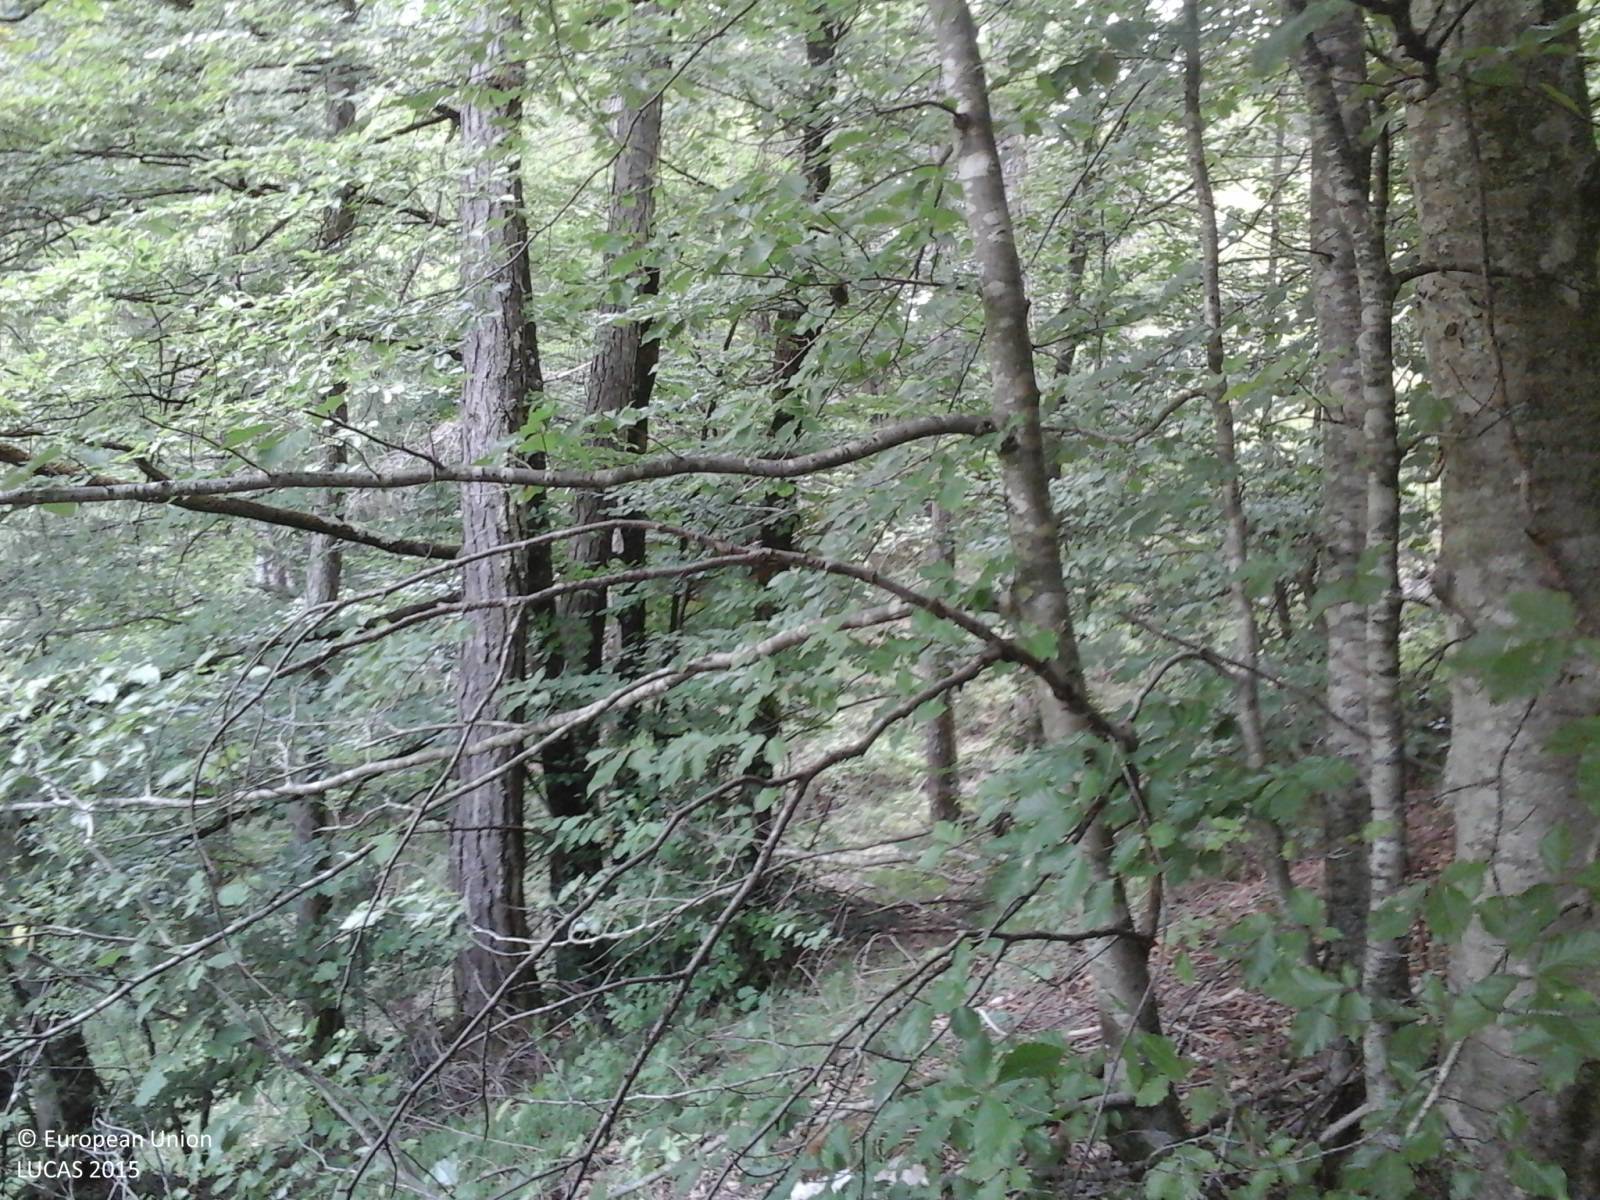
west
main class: Woodland
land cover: Broadleaved woodland
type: mountainous beech forest
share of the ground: > 75 %
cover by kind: broadleaved forest trees 75 %, coniferous forest trees 25 %
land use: Forestry
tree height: > 5 m
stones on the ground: > 50 %
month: July
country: IT
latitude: 46.2877
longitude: 12.4244
